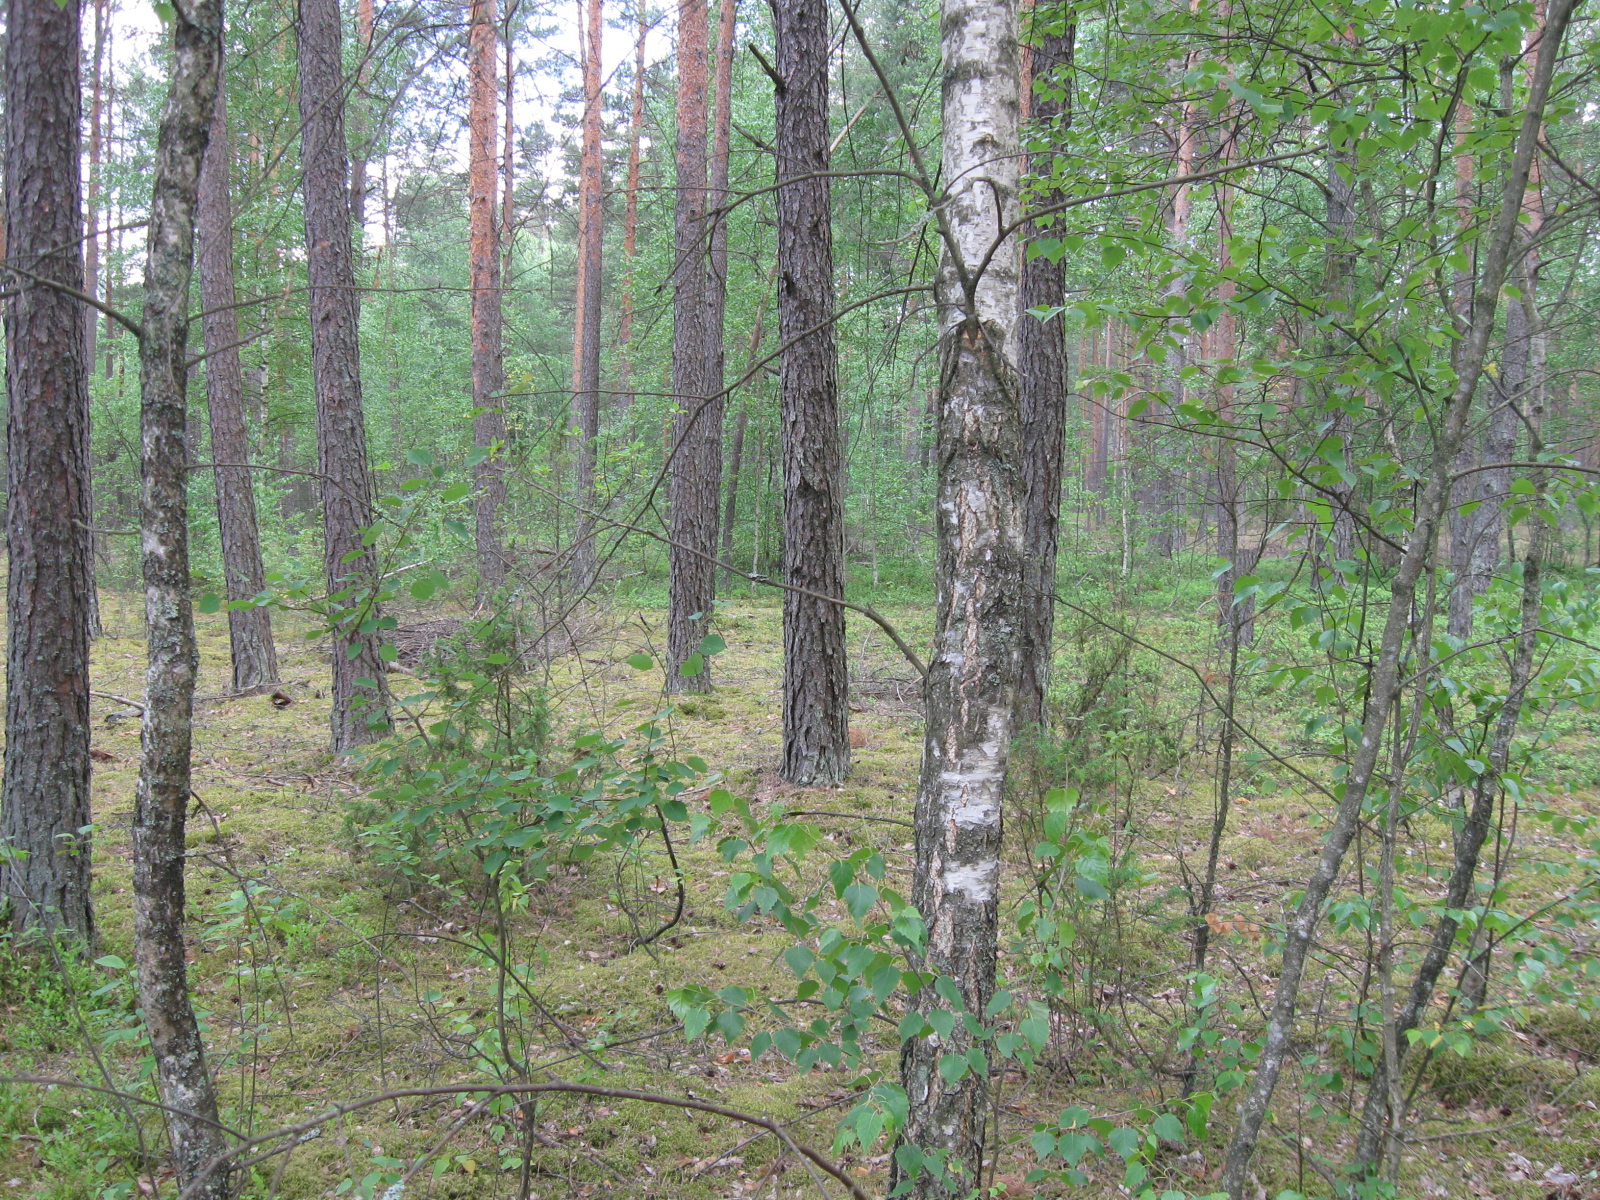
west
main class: Woodland
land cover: Pine dominated mixed woodland
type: hemiboreal forest and nemoral coniferous forest and mixed broadleaved-coniferous forest
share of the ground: > 75 %
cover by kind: coniferous forest trees 45 %, broadleaved forest trees 30 %, lichens and mosses 25 %
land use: Forestry
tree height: > 5 m
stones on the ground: < 10 %
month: July
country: LT
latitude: 54.1915
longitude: 24.3067
